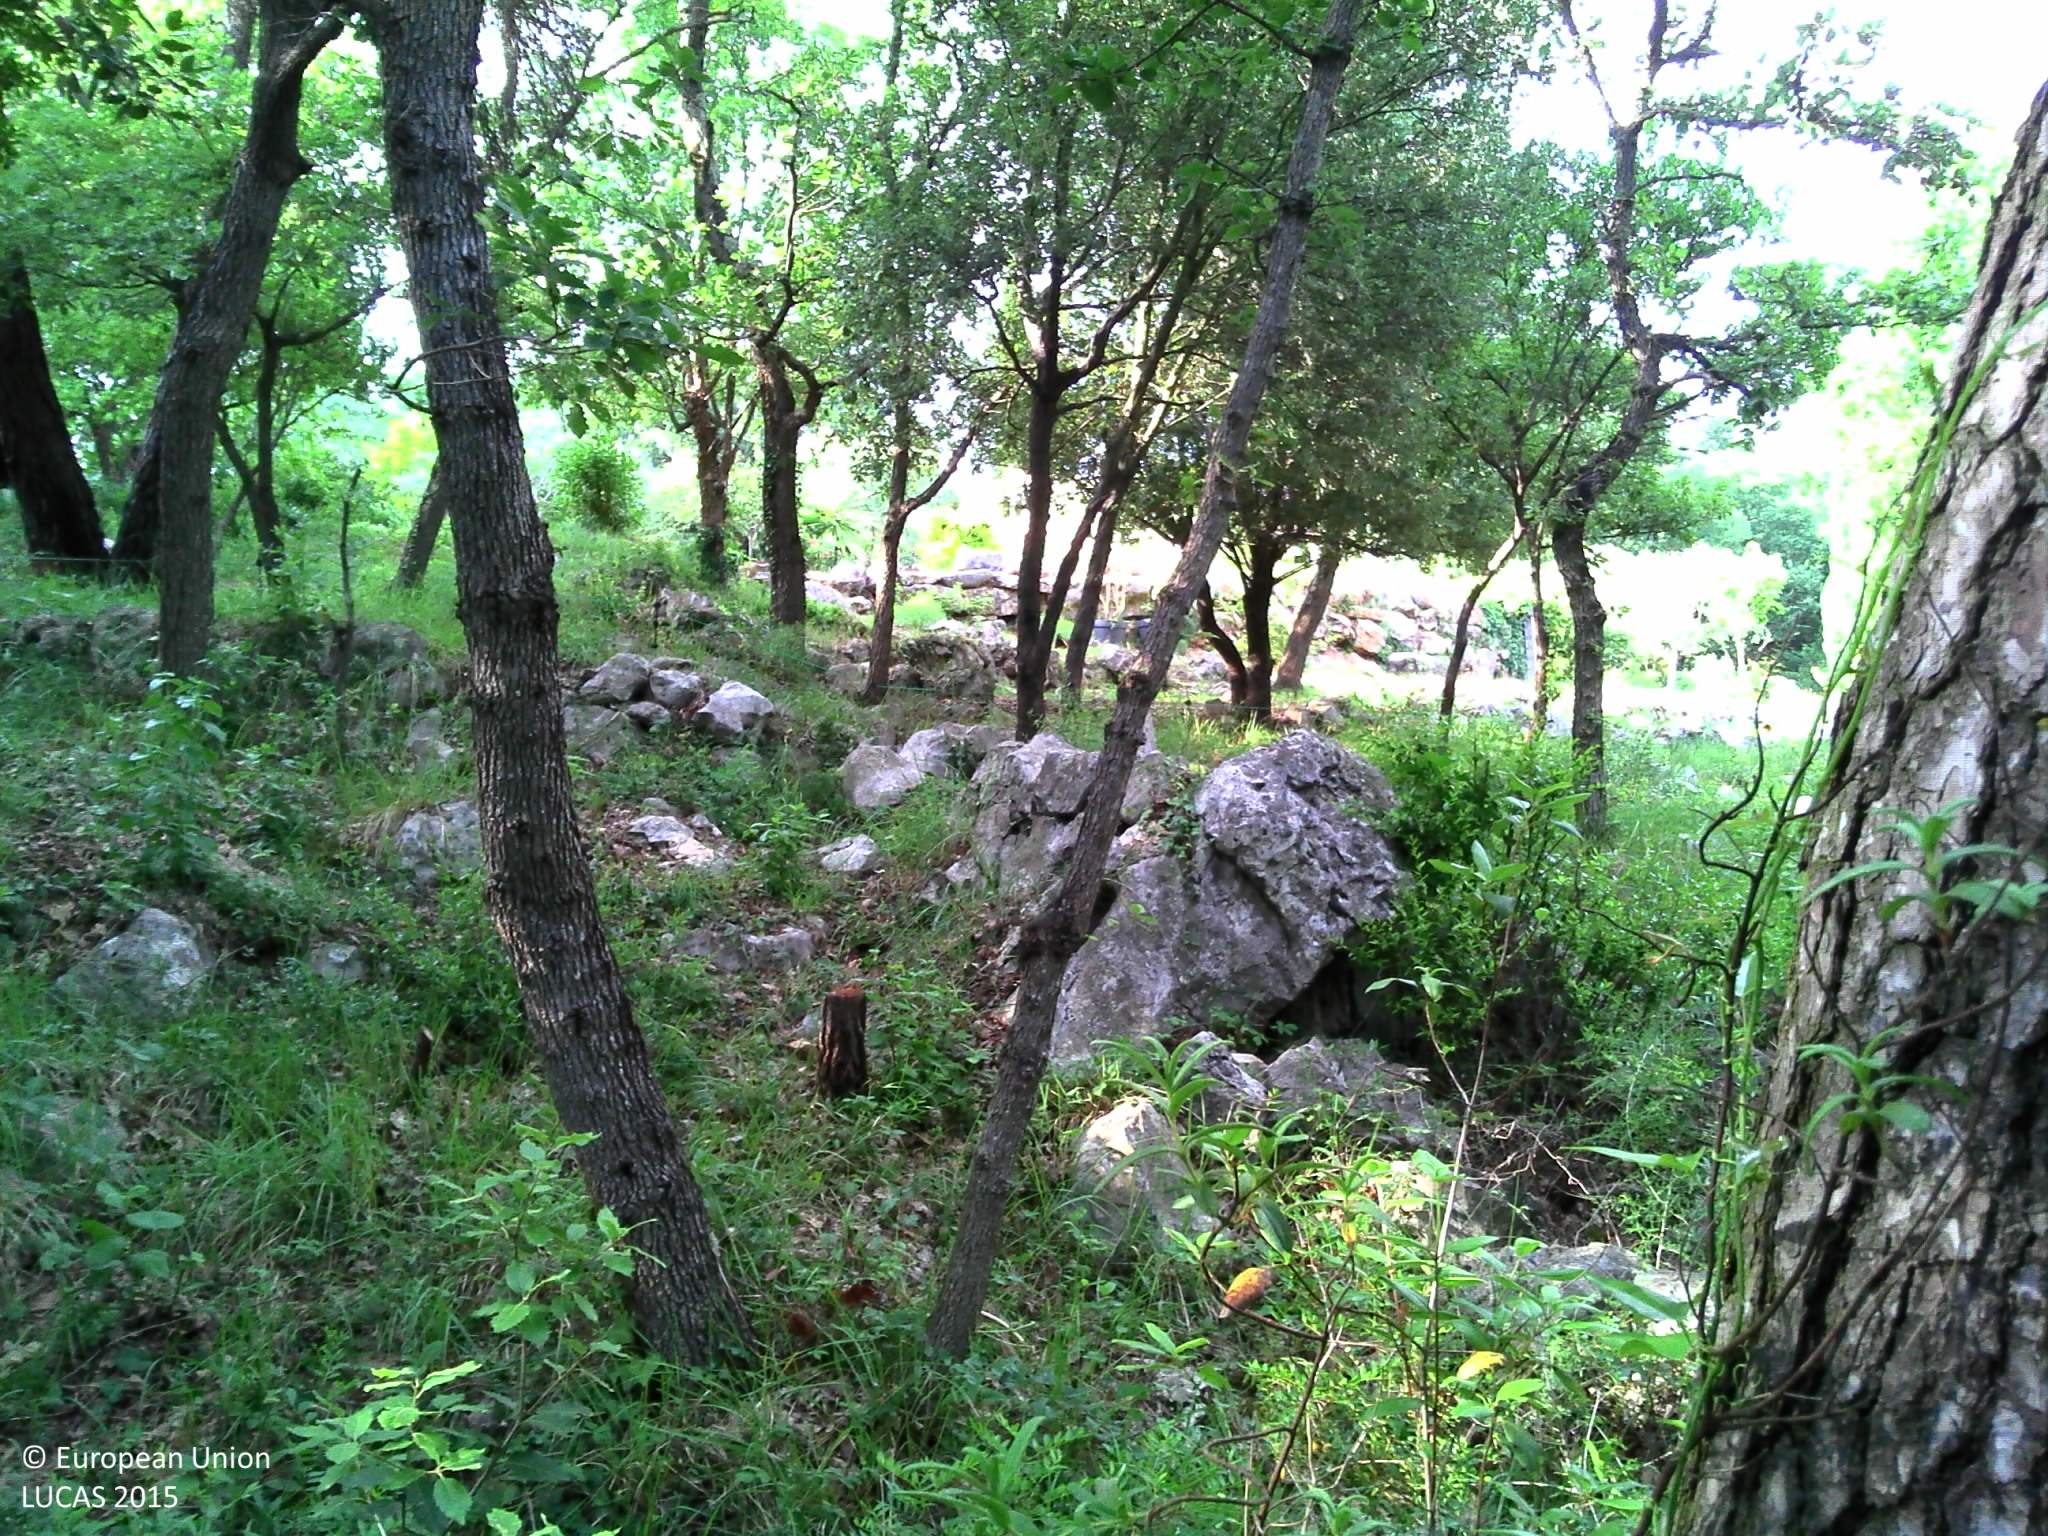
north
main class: Woodland
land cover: Pine dominated mixed woodland
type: thermophilous deciduous forest
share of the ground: > 75 %
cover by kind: broadleaved forest trees 45 %, coniferous forest trees 35 %, shrubs 15 %, herbaceous plants 5 %
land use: Forestry
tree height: > 5 m
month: June
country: FR
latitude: 43.6399
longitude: 7.0198
